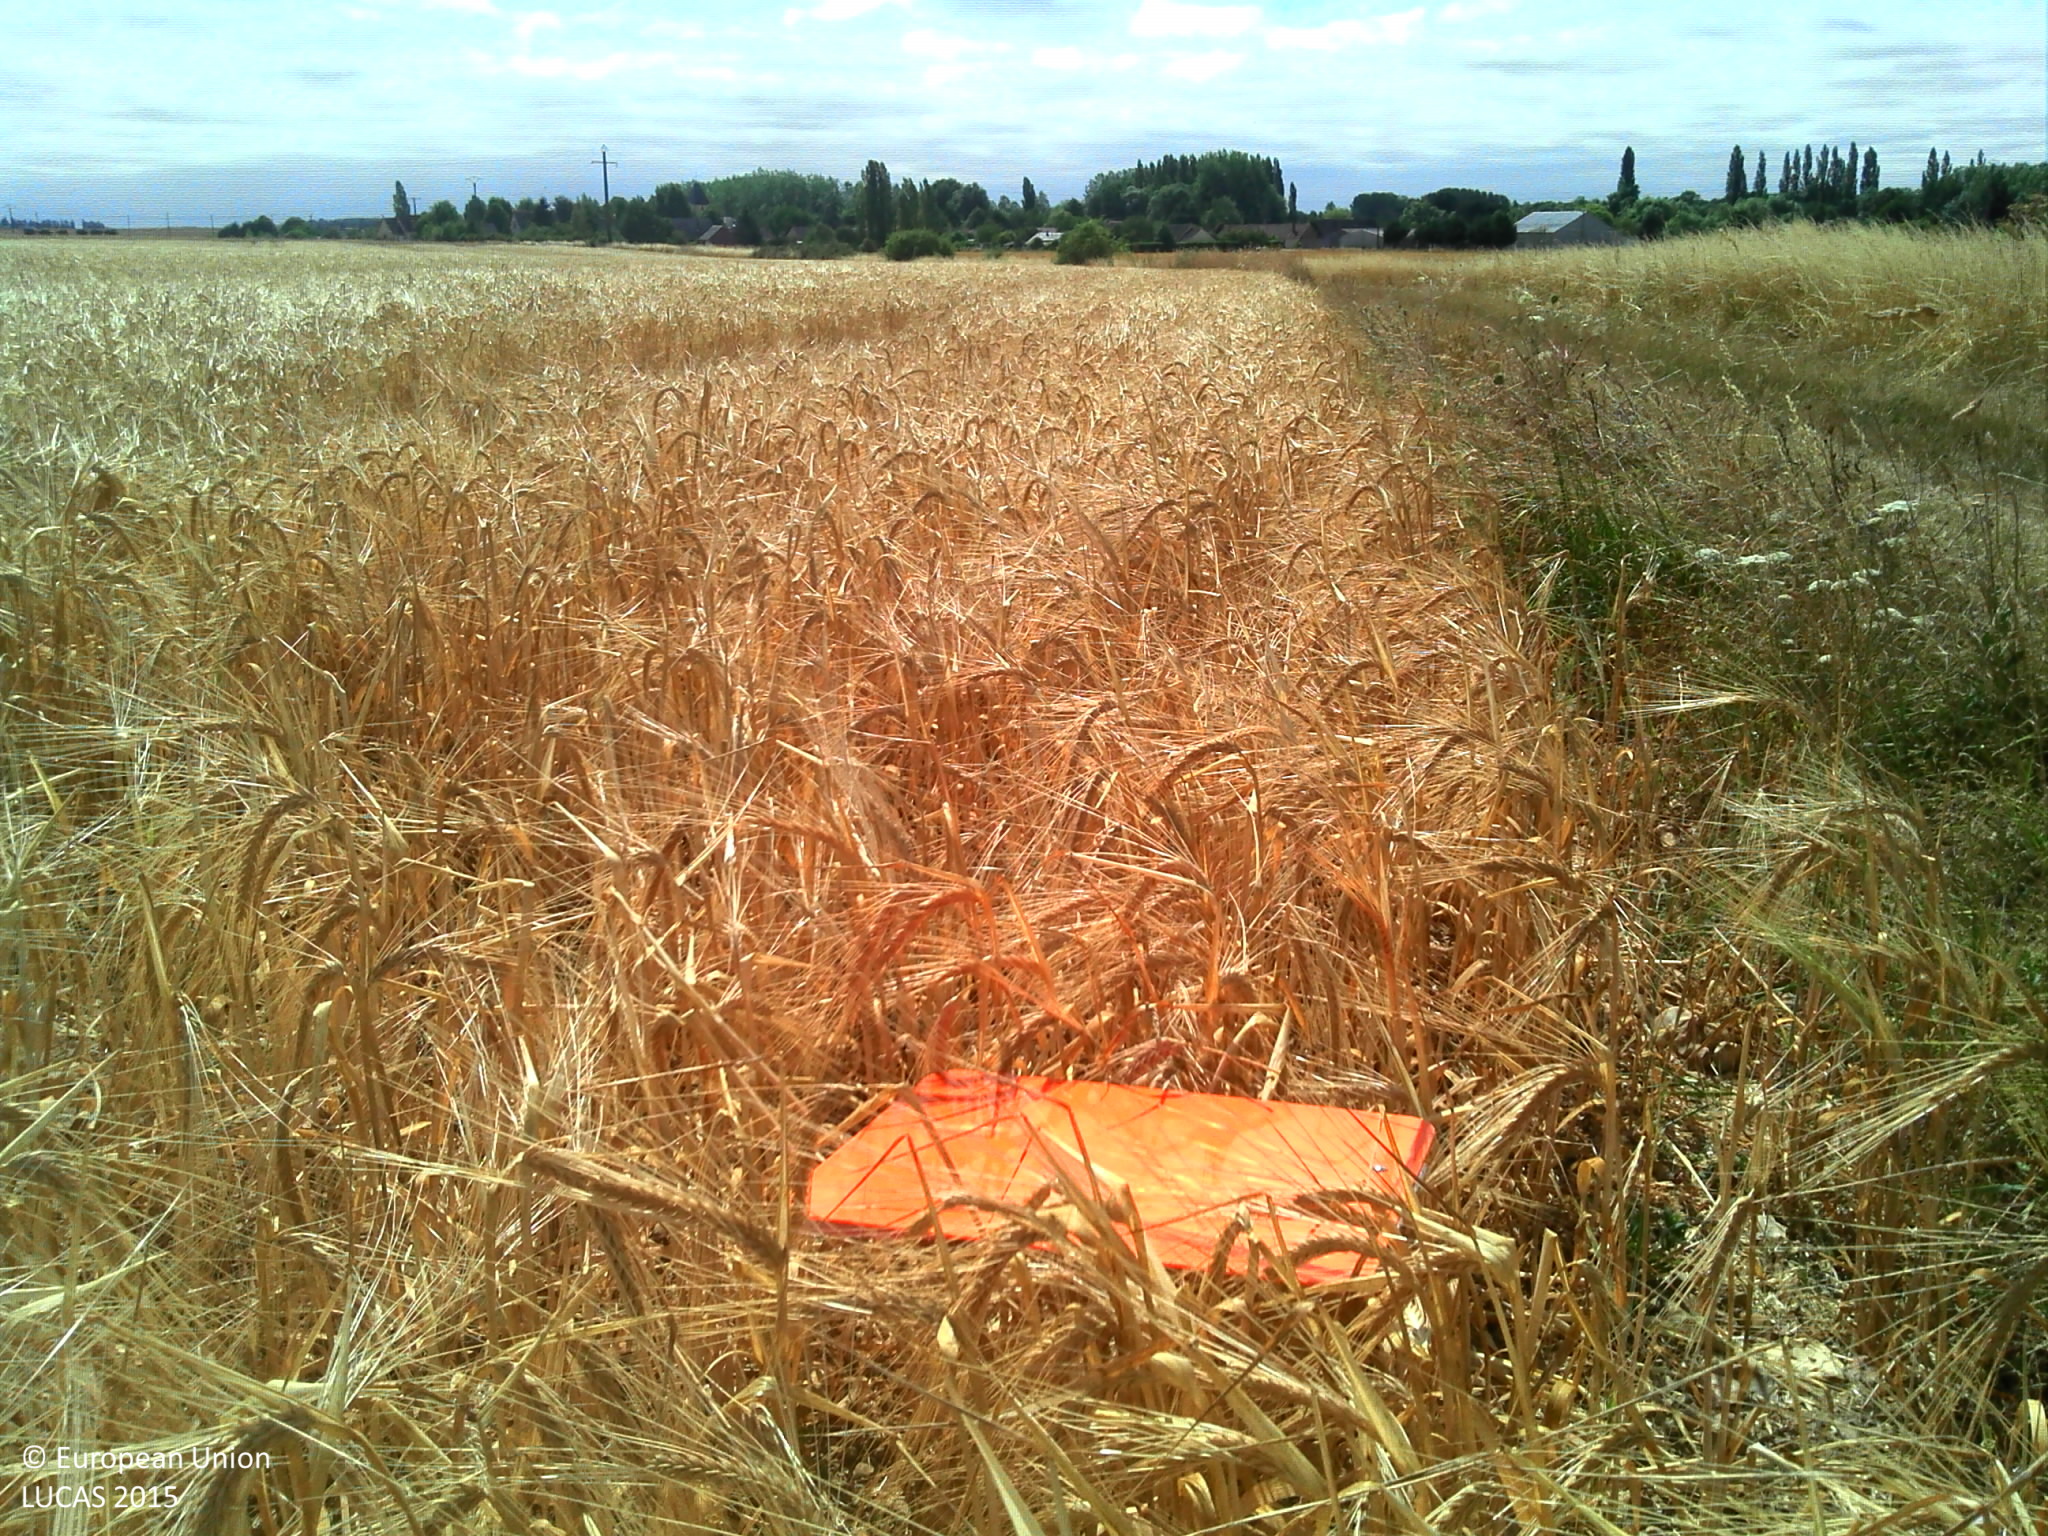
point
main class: Cropland
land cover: Barley
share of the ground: > 75 %
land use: Agriculture (excluding fallow land and kitchen gardens)
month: July
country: FR
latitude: 48.2744
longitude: 1.2643
